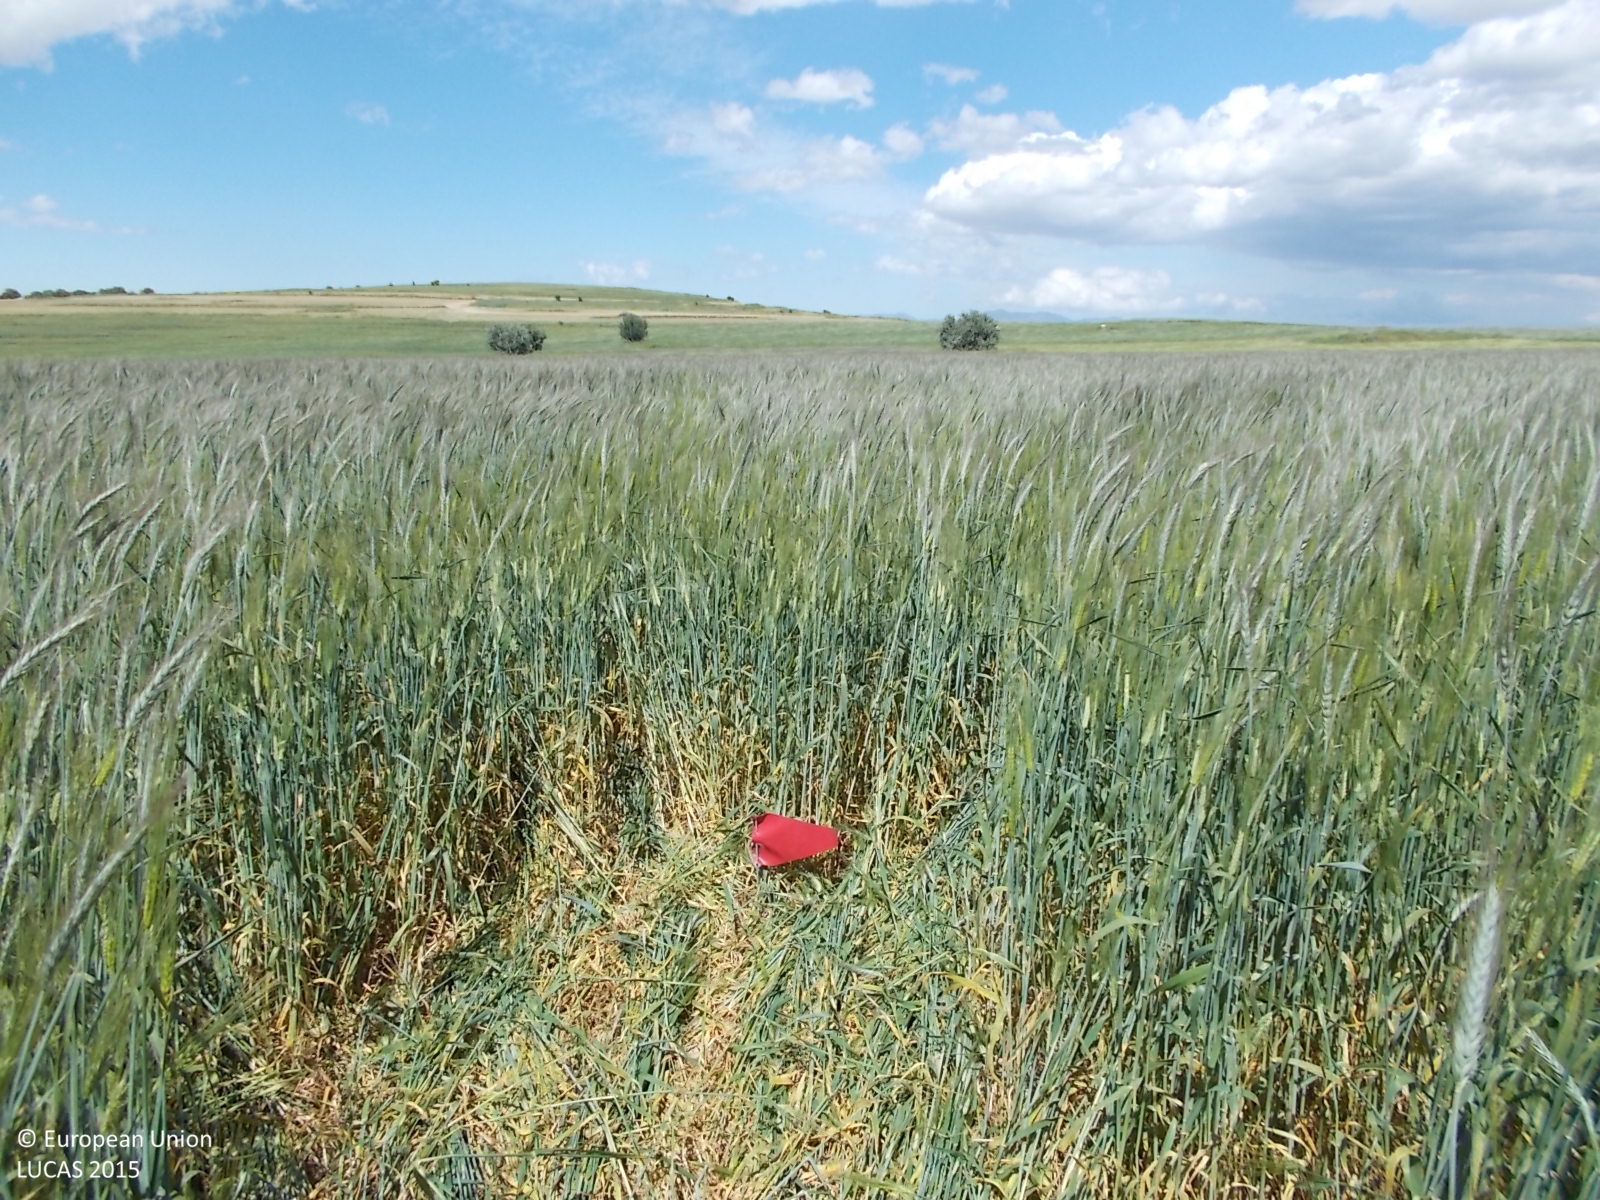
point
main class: Cropland
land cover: Mixed cereals for fodder
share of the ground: > 75 %
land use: Agriculture (excluding fallow land and kitchen gardens)
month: April
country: CY
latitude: 35.0199
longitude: 33.5055
